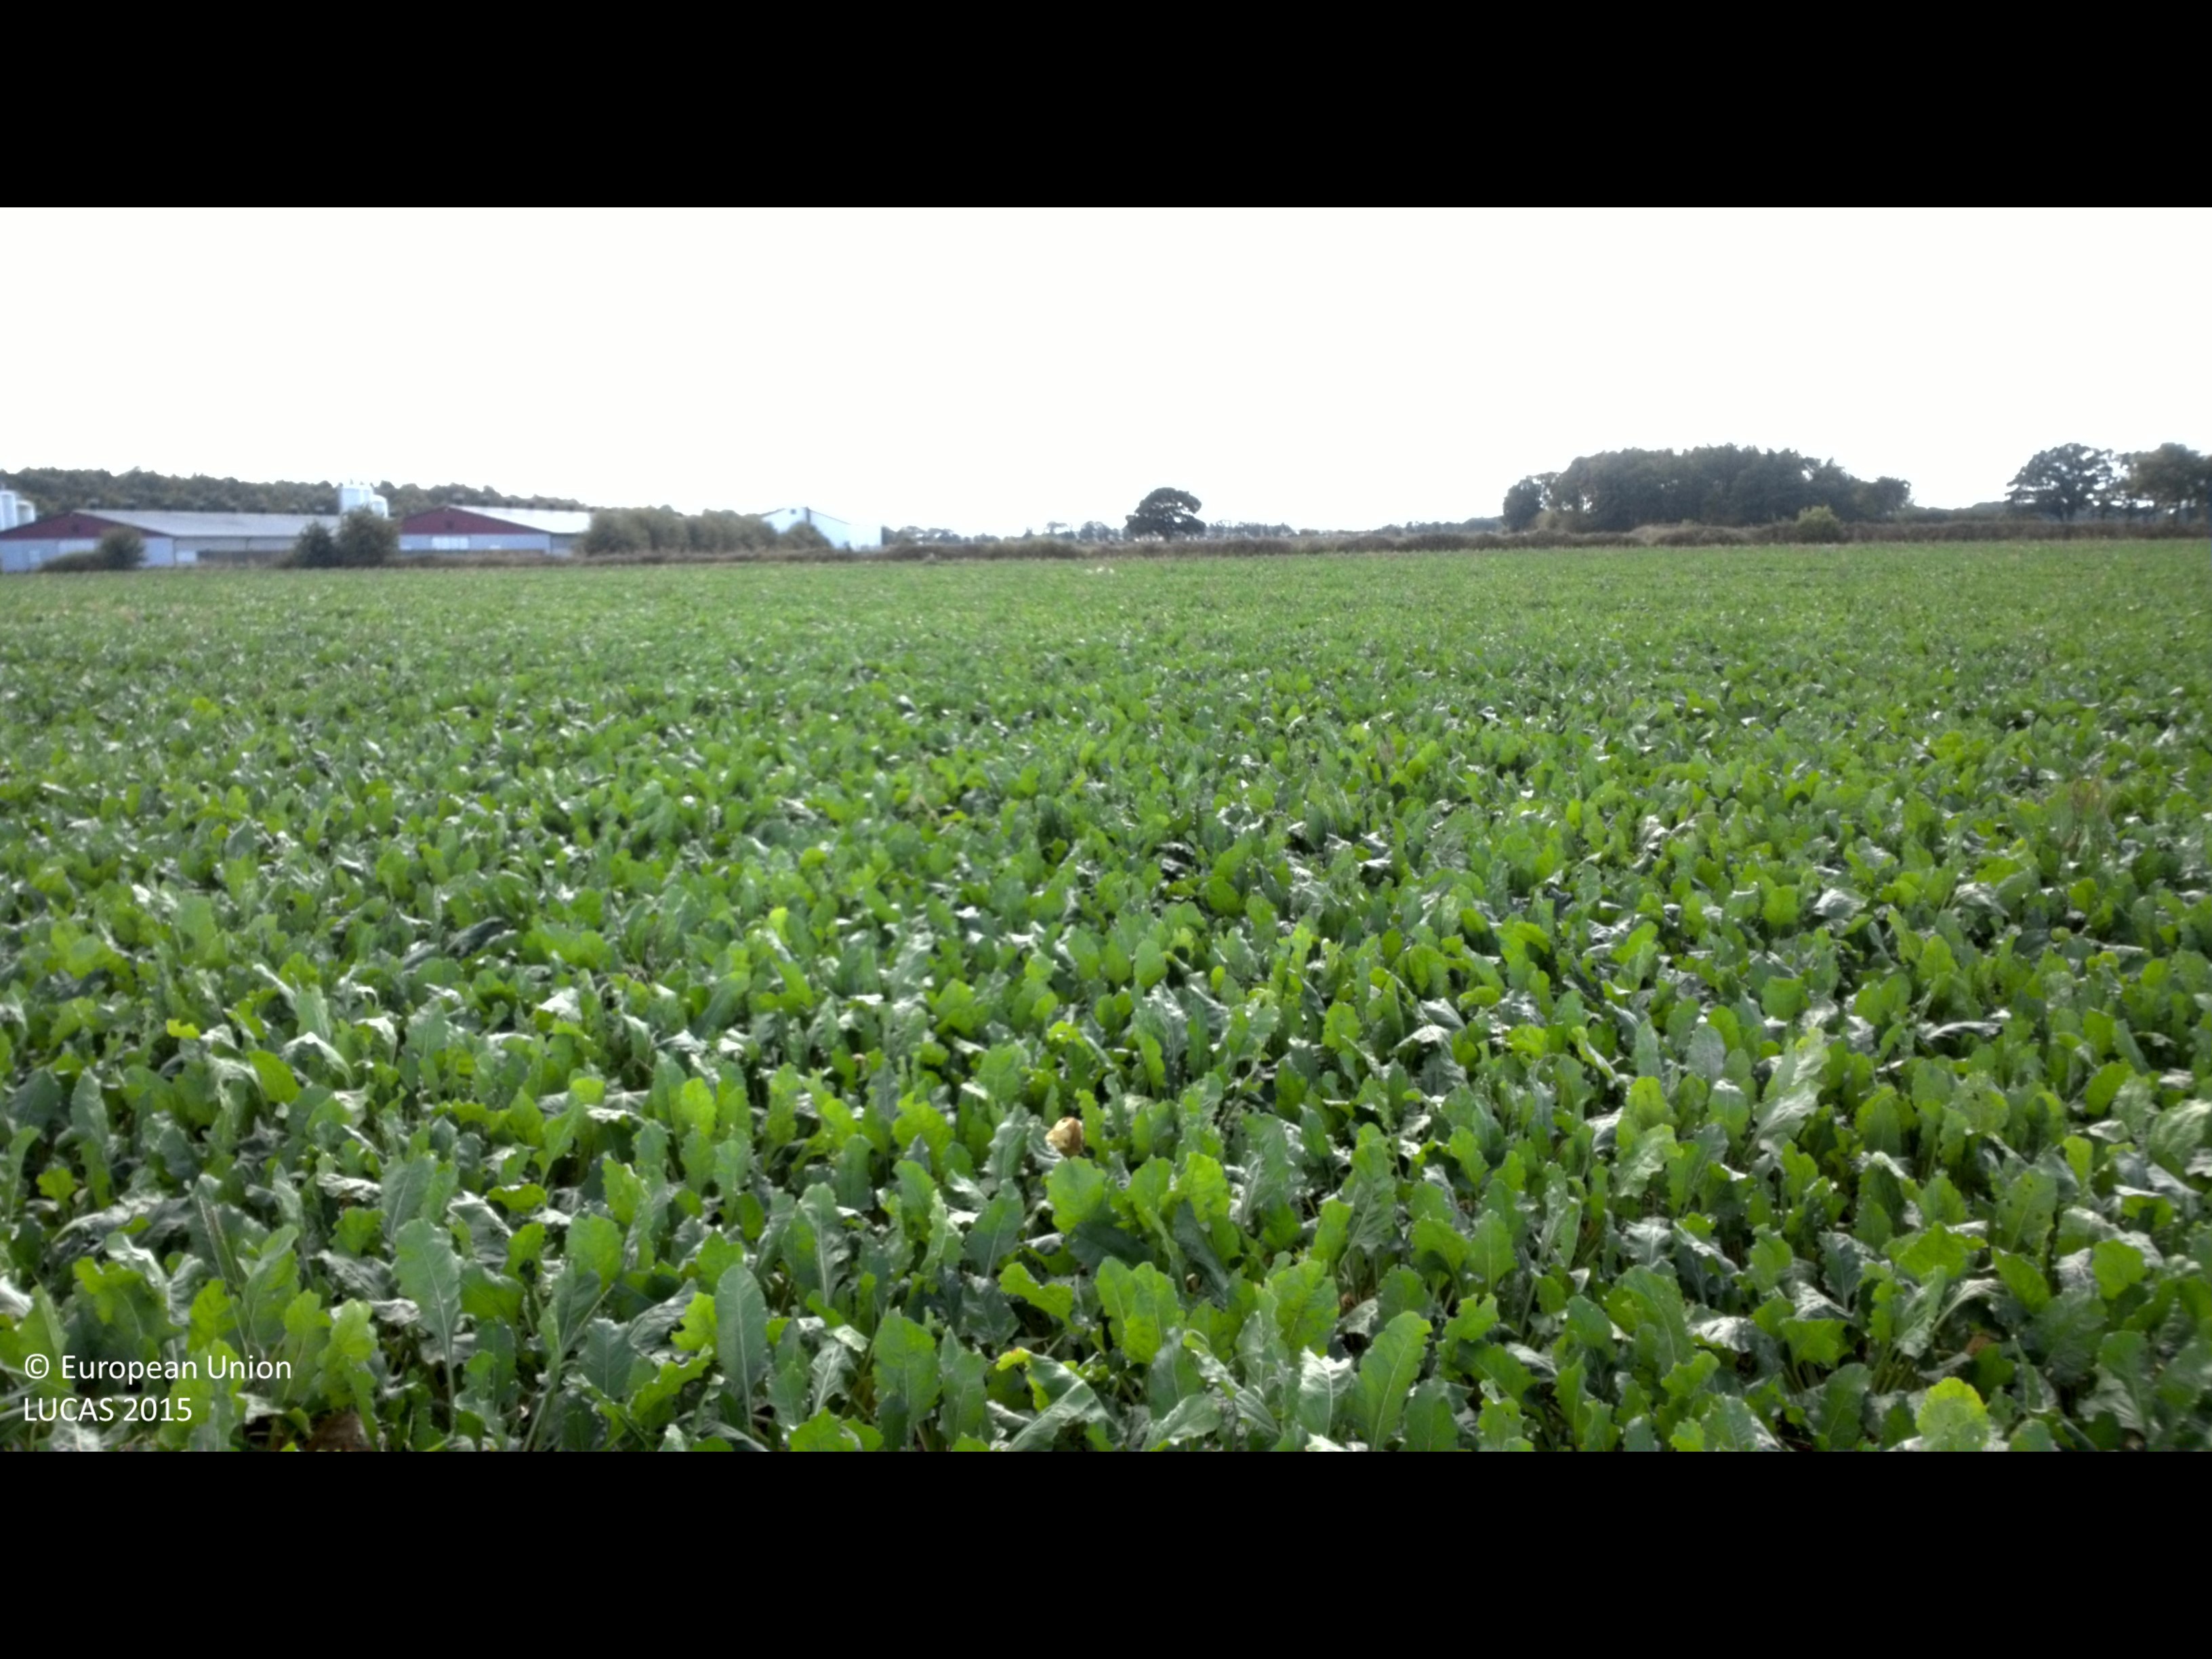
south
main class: Cropland
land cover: Sugar beet
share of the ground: > 75 %
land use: Agriculture (excluding fallow land and kitchen gardens)
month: September
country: SE
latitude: 56.1026
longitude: 14.6769
